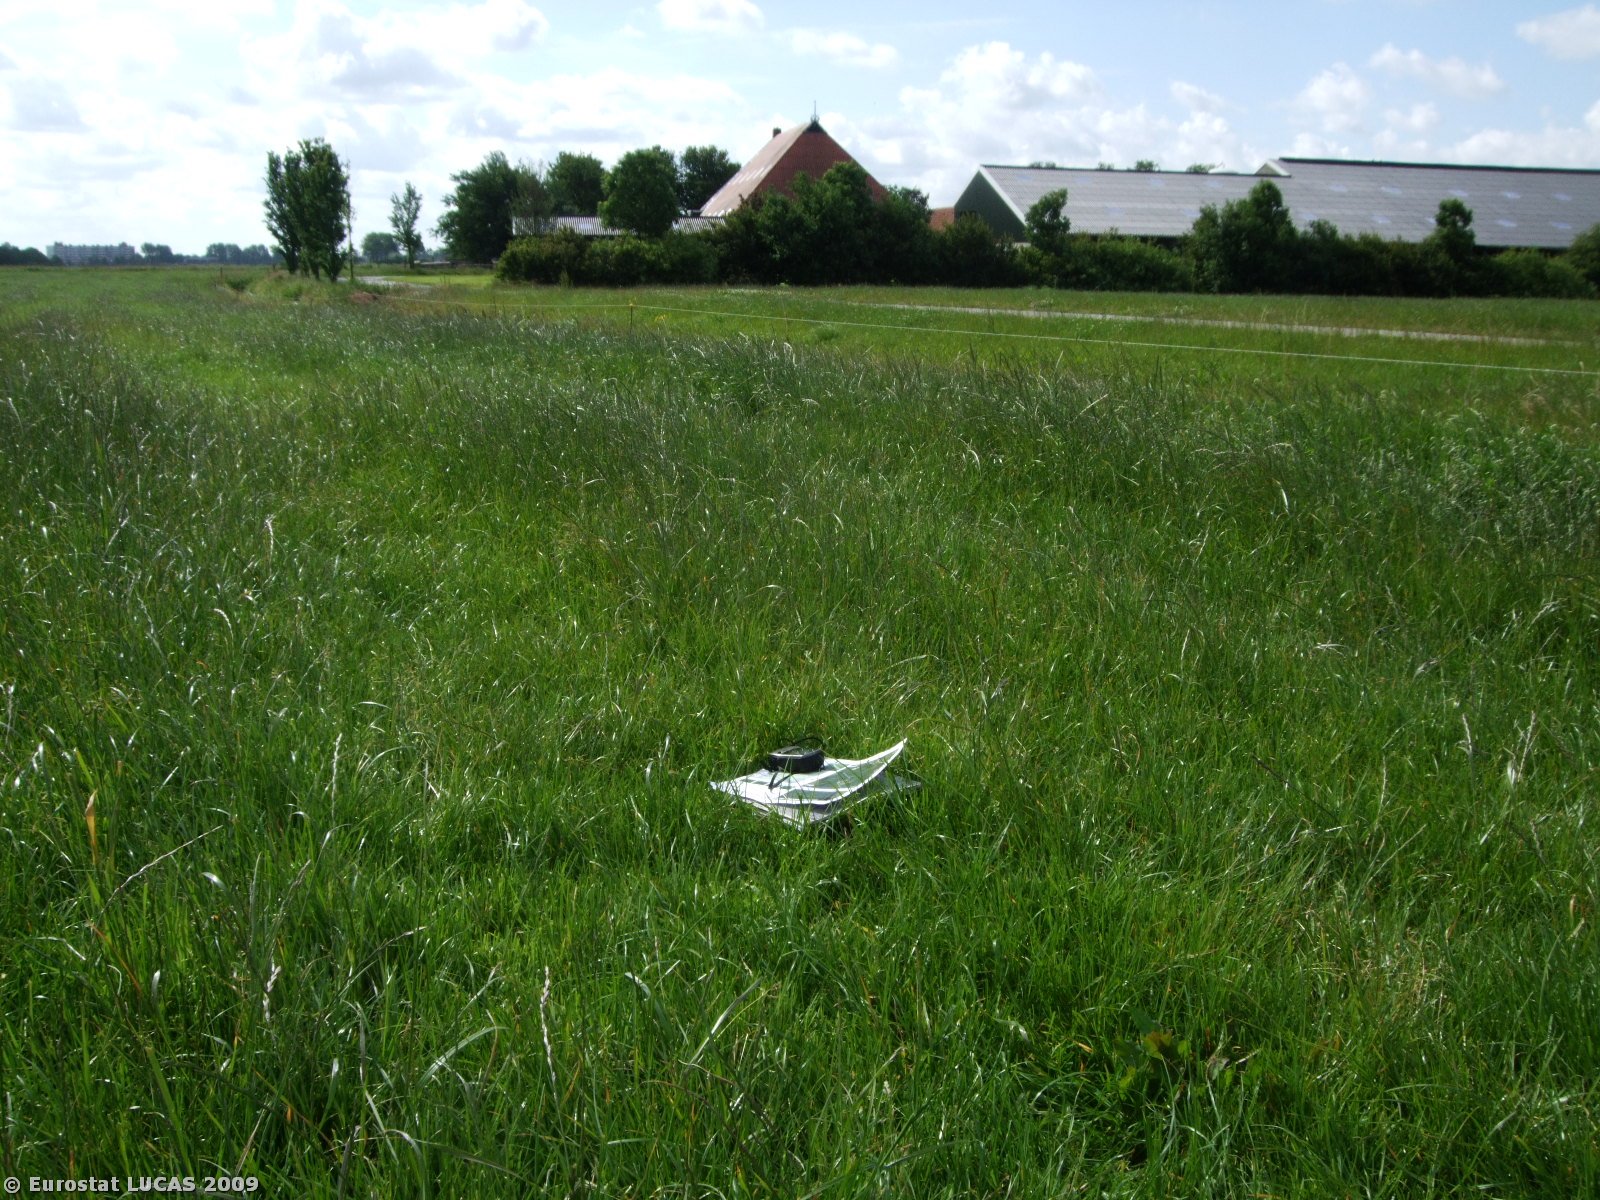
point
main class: Grassland
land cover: Grassland without tree/shrub cover
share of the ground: > 75 %
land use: Agriculture (excluding fallow land and kitchen gardens)
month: June
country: NL
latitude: 53.0530
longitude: 5.6277
